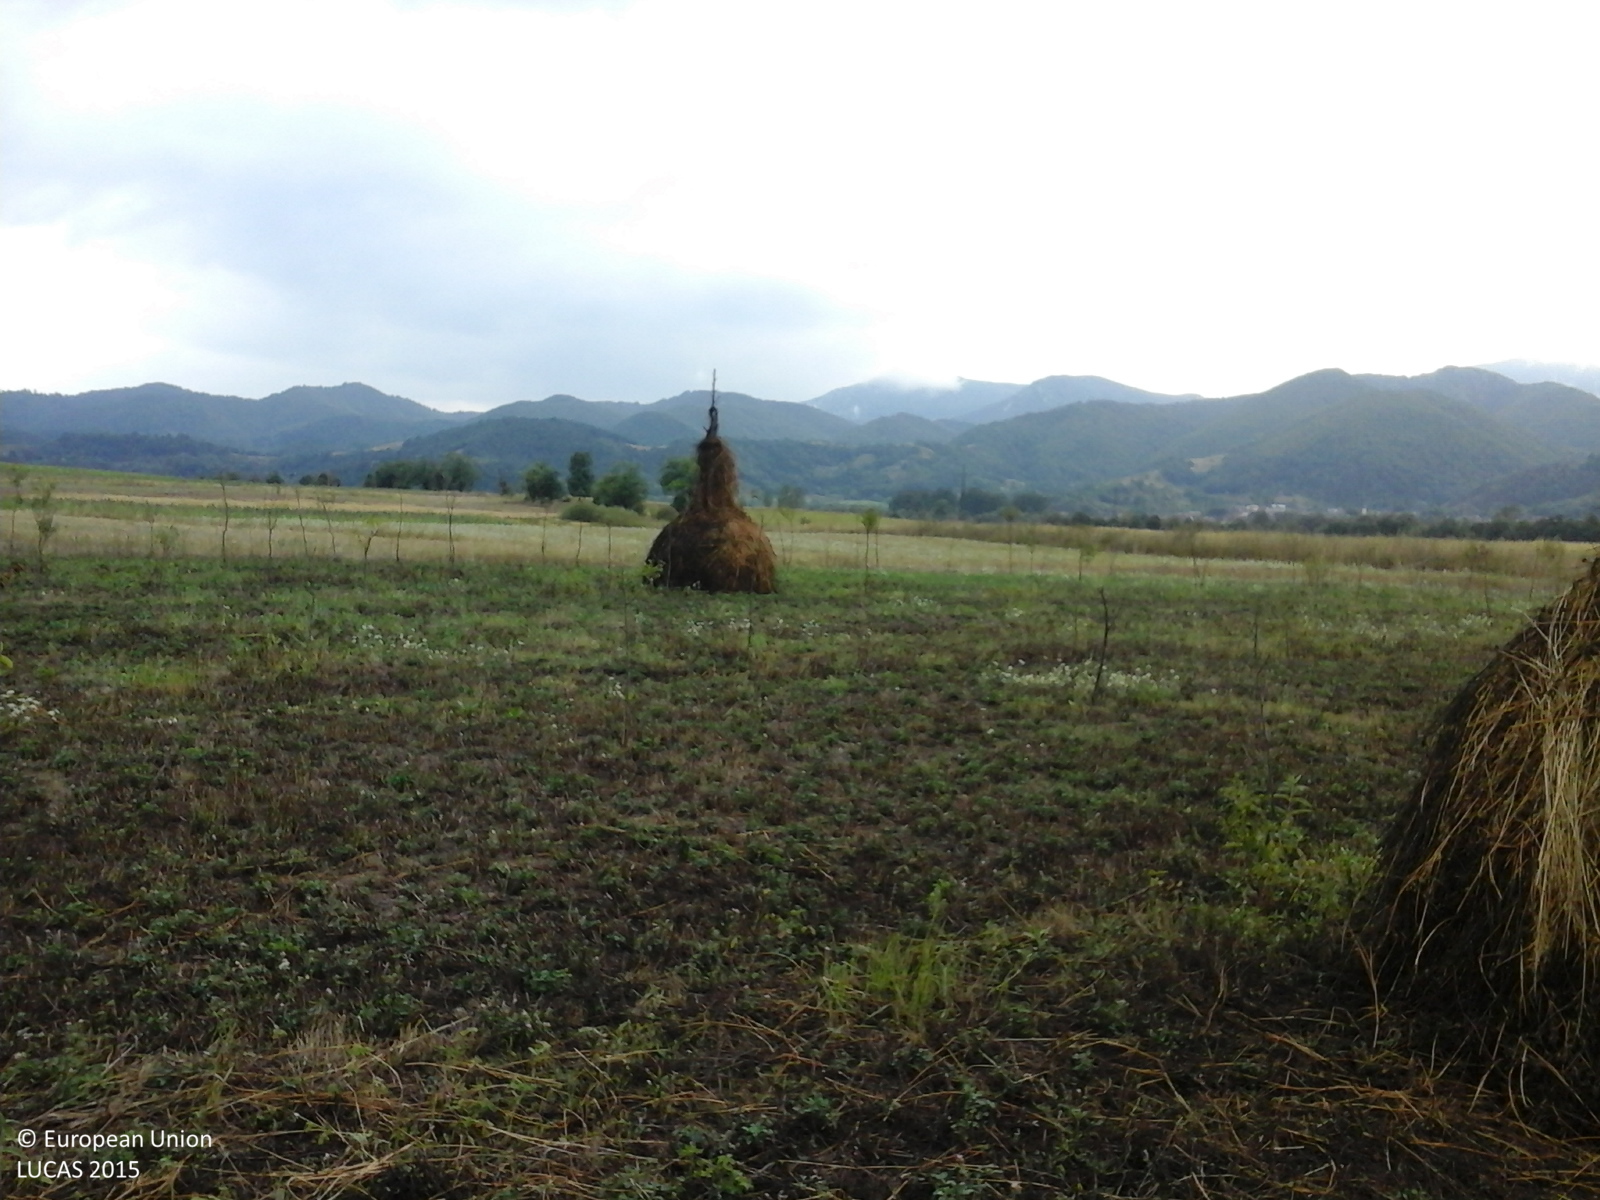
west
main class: Cropland
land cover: Apple fruit
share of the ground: > 75 %
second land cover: Lucerne
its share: > 75 %
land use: Agriculture (excluding fallow land and kitchen gardens)
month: August
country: RO
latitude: 44.8603
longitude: 21.9421
